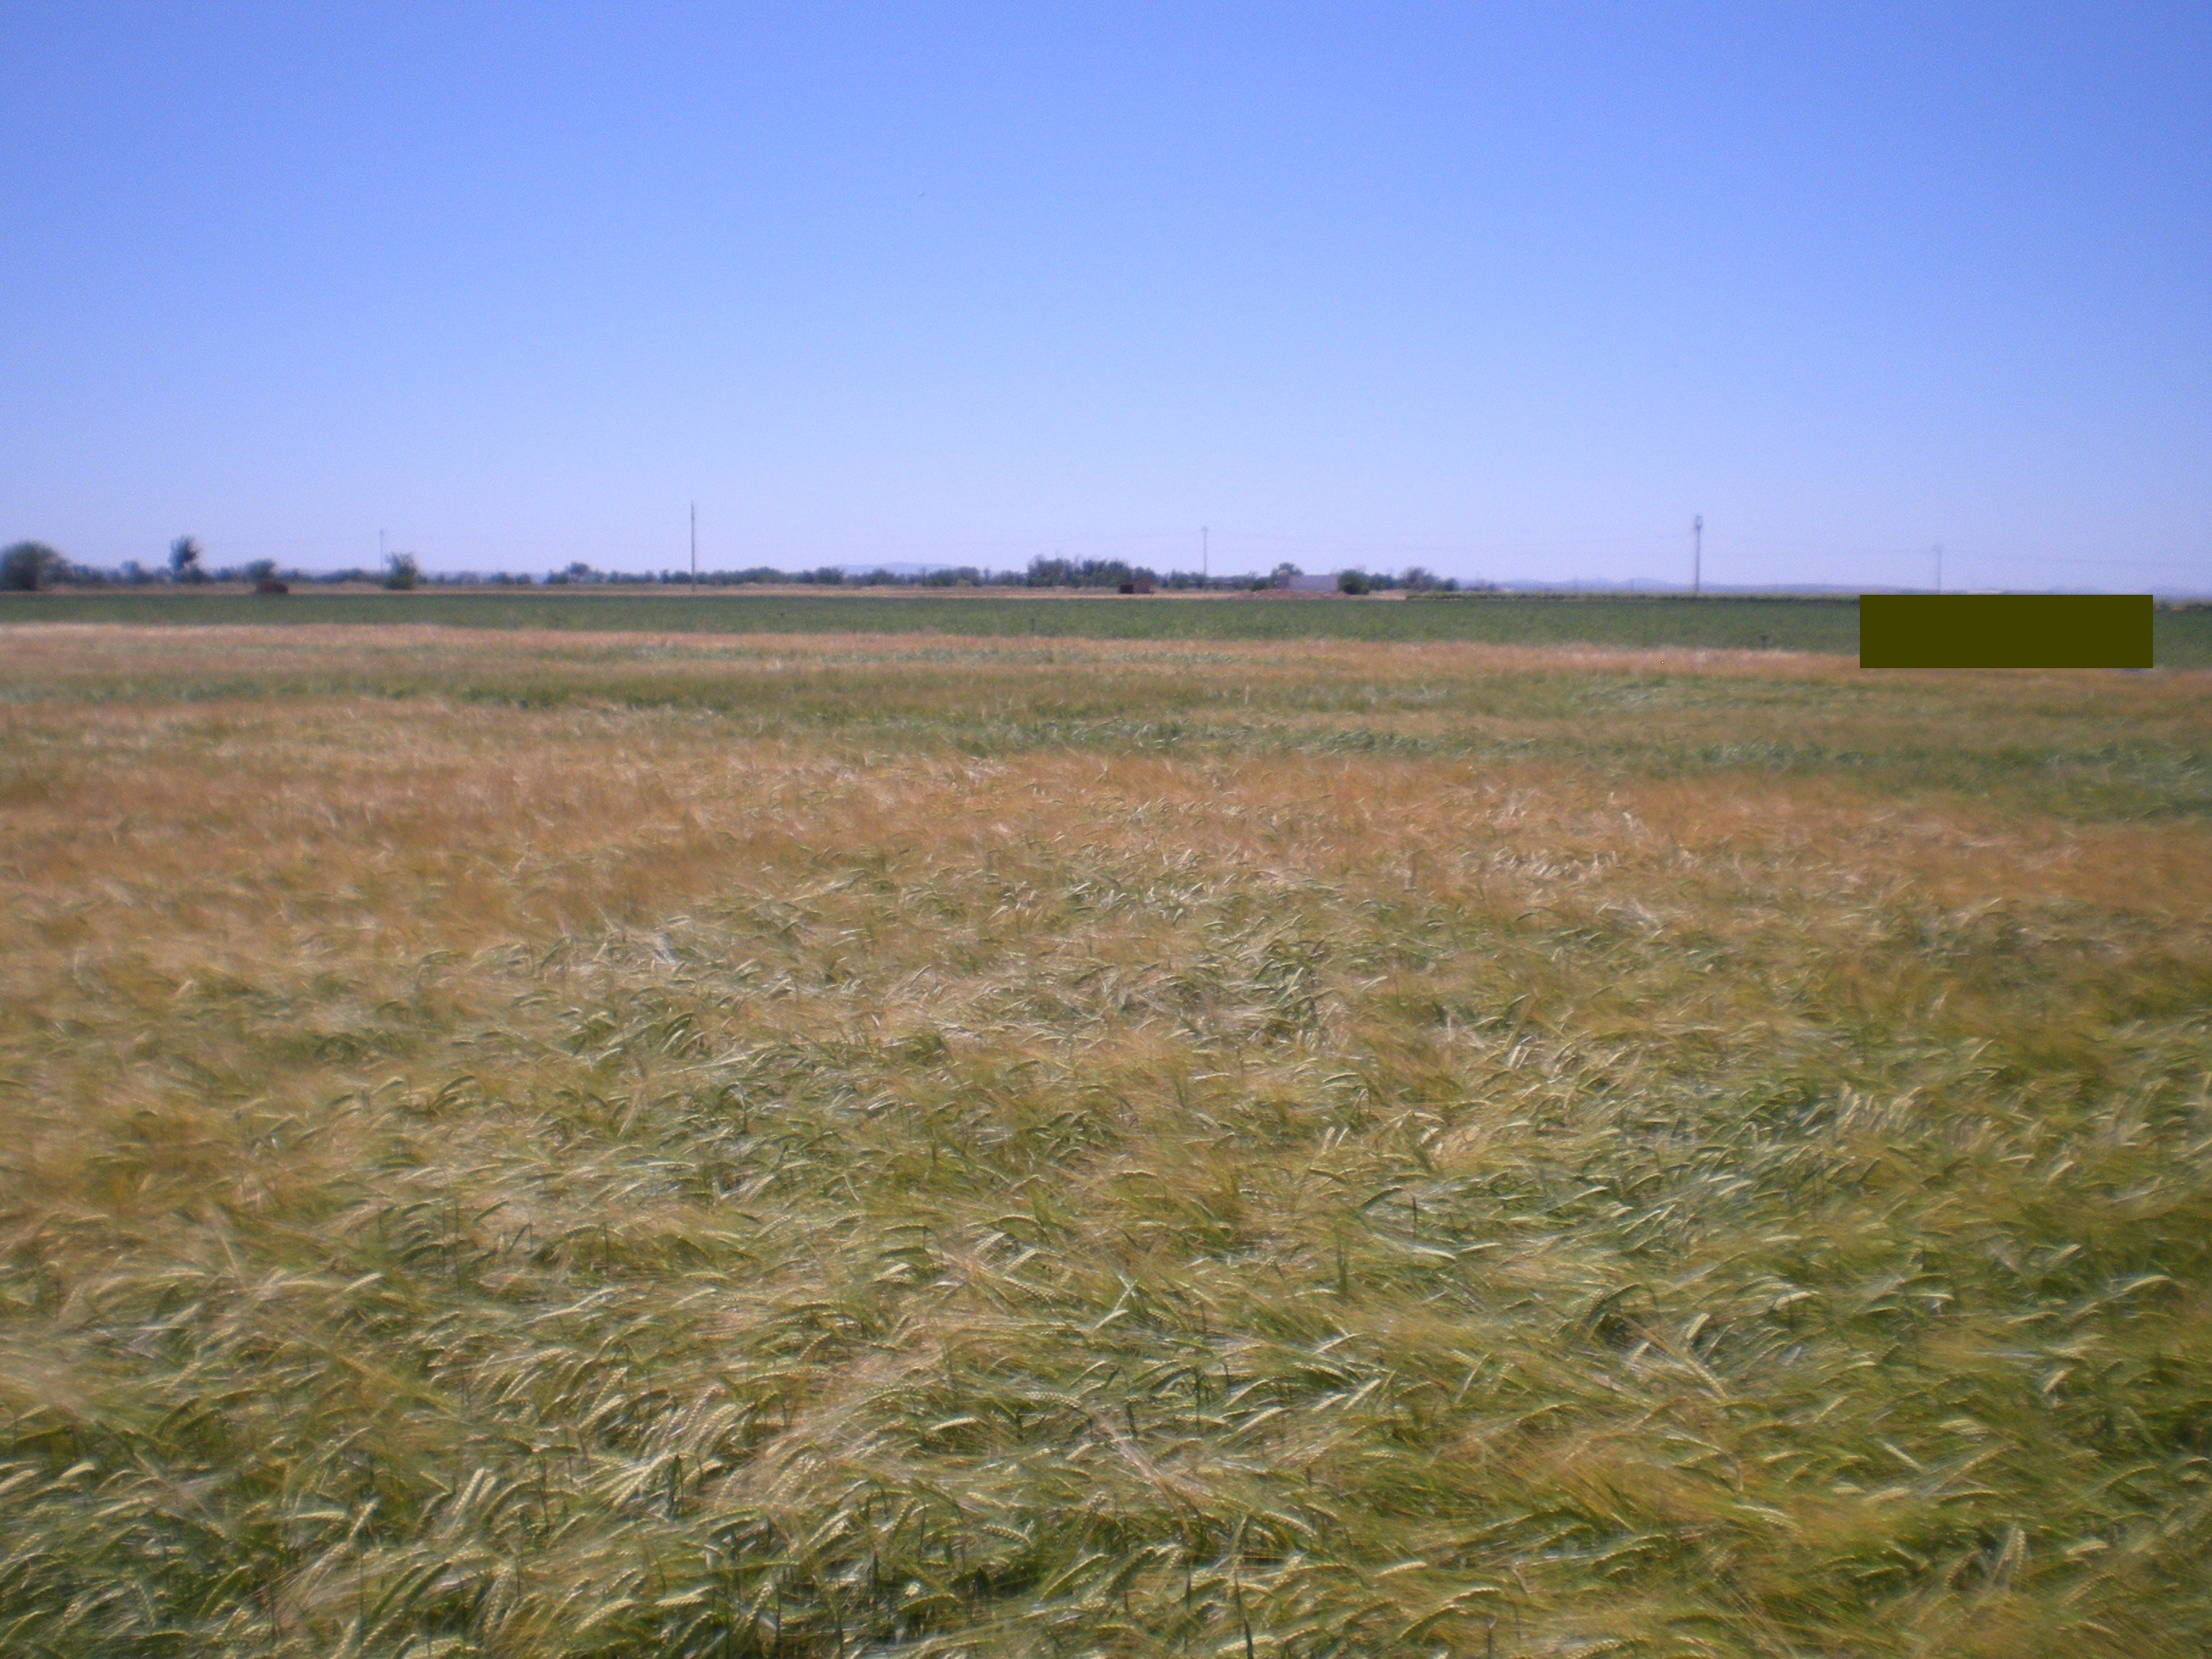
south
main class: Cropland
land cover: Barley
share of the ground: > 75 %
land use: Agriculture (excluding fallow land and kitchen gardens)
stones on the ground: 10 - 25 %
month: May
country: ES
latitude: 39.1437
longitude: -3.1225
